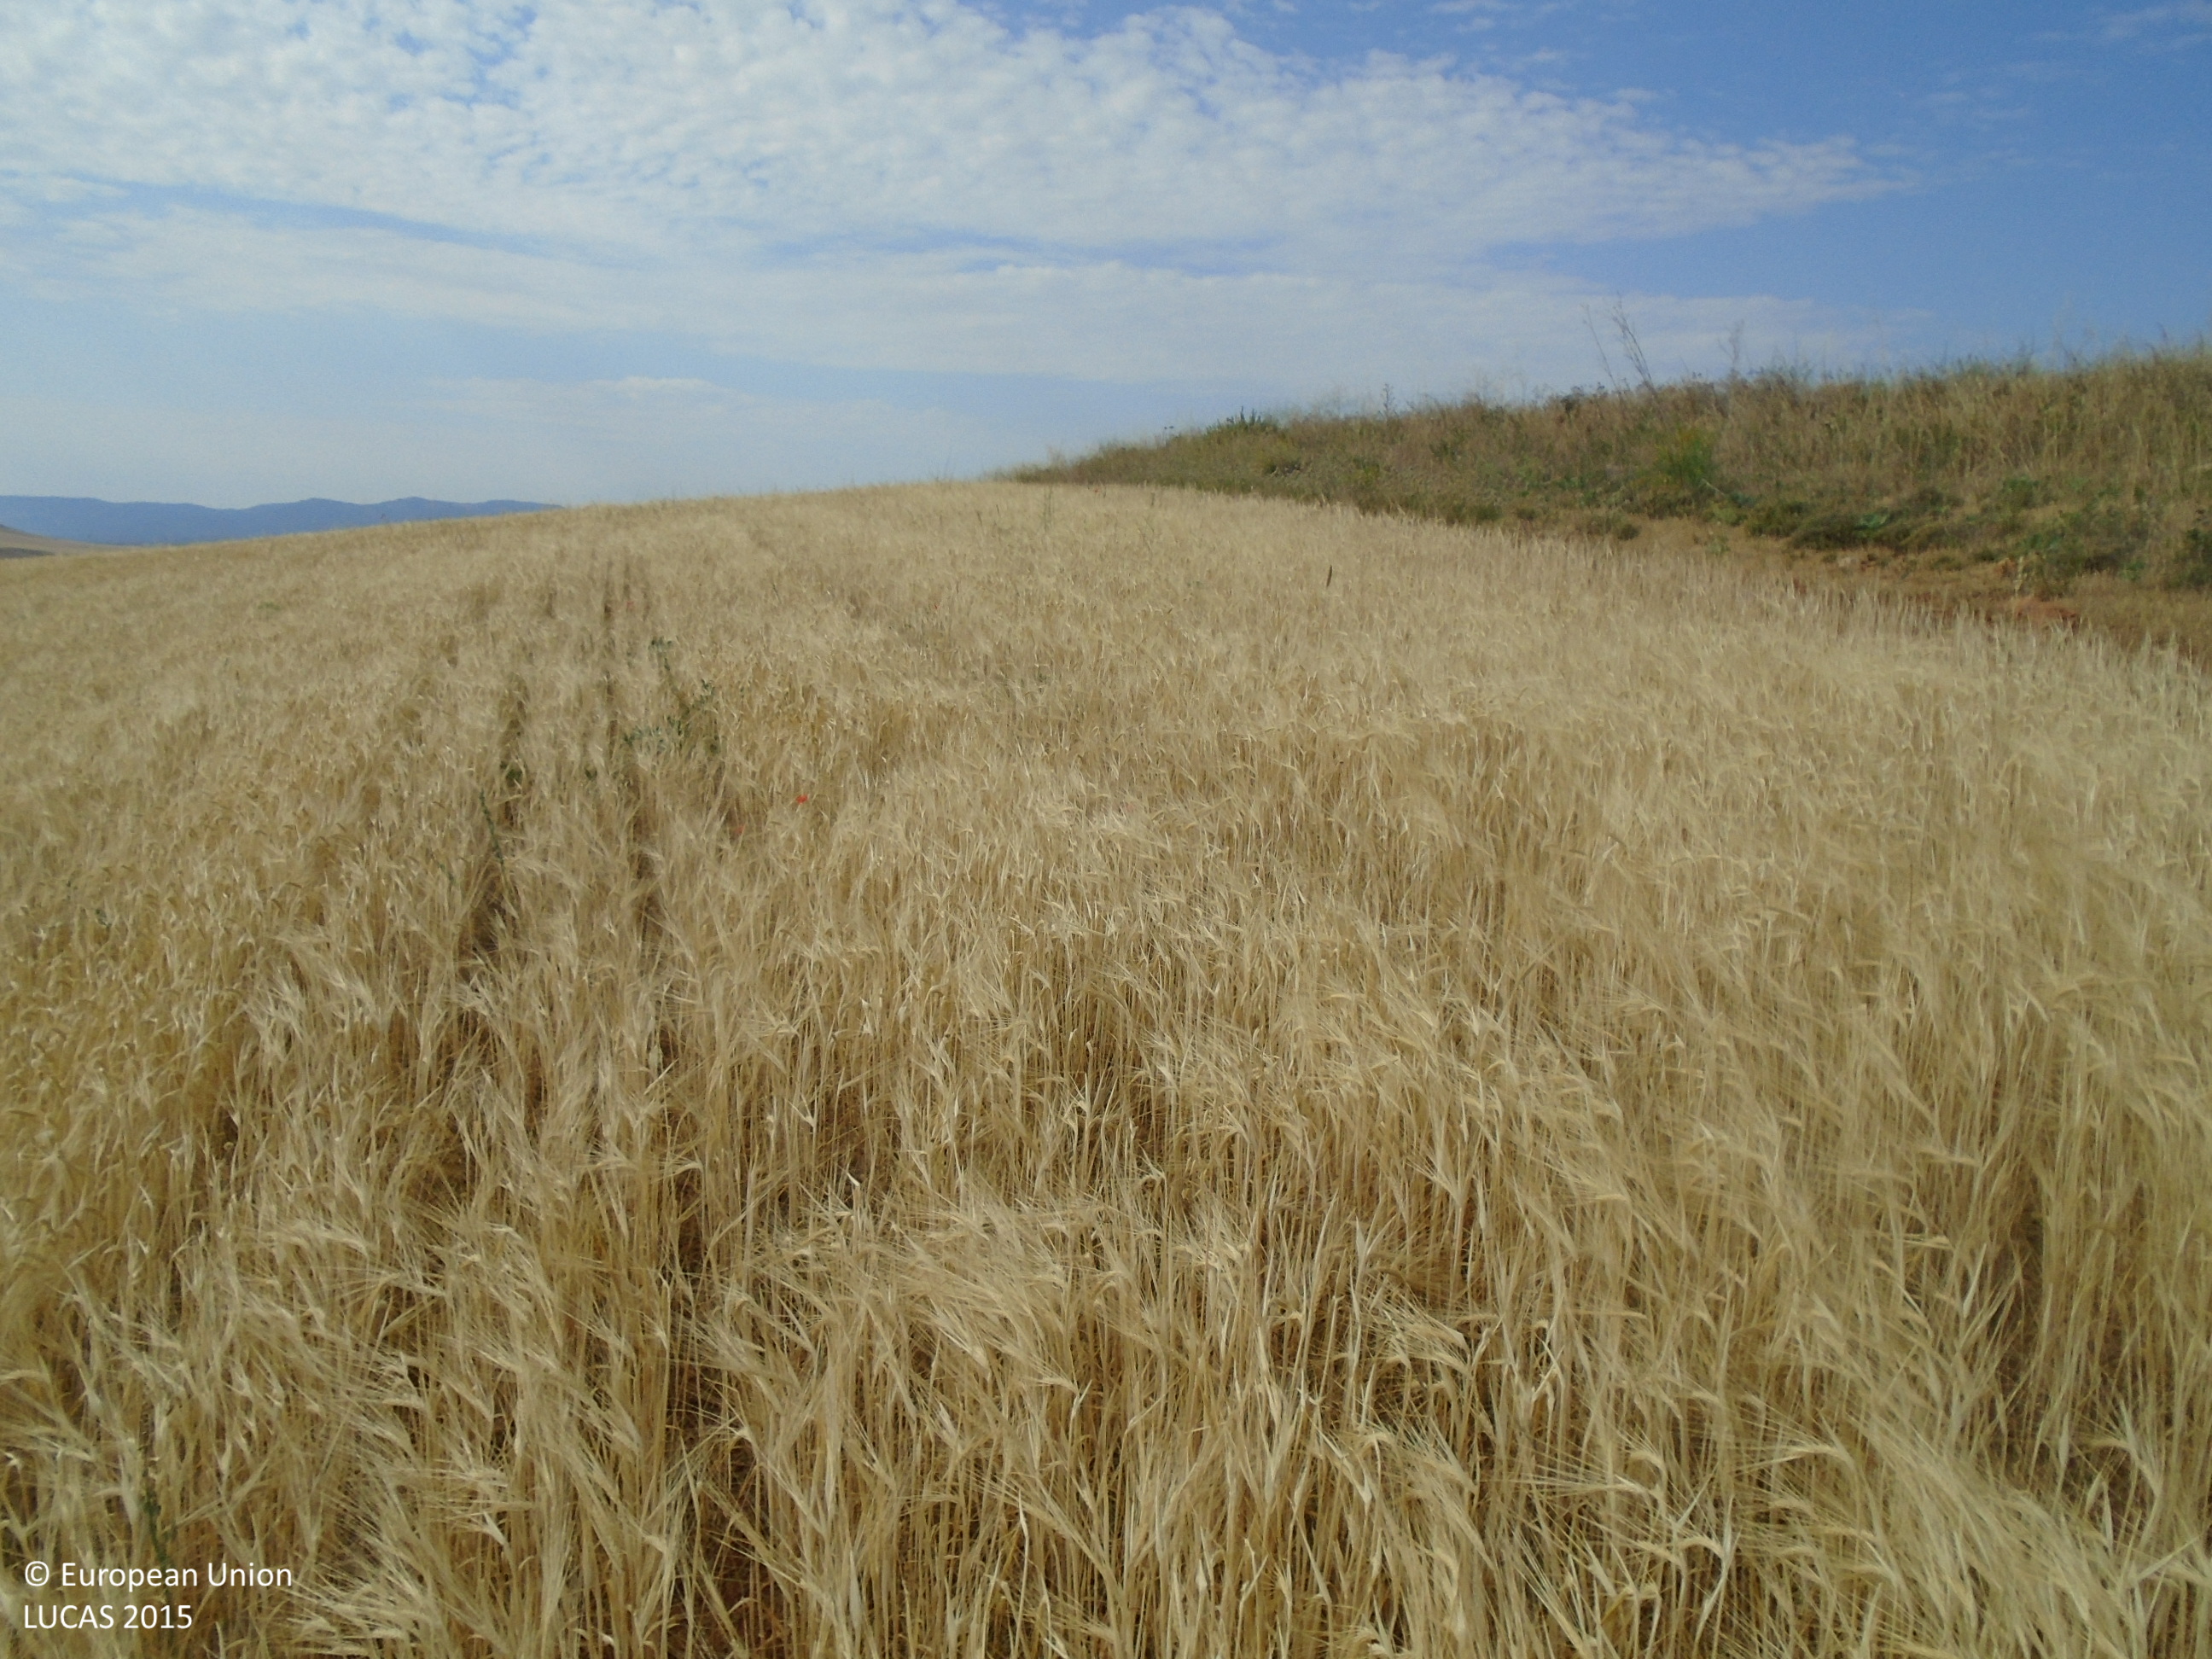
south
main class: Cropland
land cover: Barley
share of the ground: > 75 %
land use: Agriculture (excluding fallow land and kitchen gardens)
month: June
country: ES
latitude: 39.7436
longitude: -4.1904
